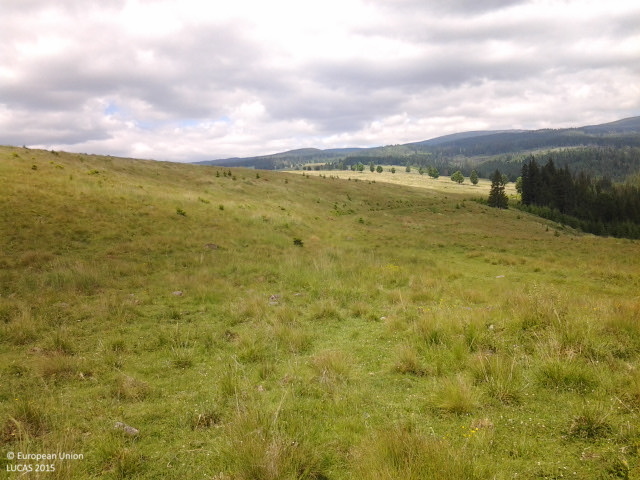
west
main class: Grassland
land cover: Grassland without tree/shrub cover
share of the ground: > 75 %
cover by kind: herbaceous plants 100 %
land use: Agriculture (excluding fallow land and kitchen gardens)
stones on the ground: 10 - 25 %
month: June
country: RO
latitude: 47.0501
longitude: 25.3392
